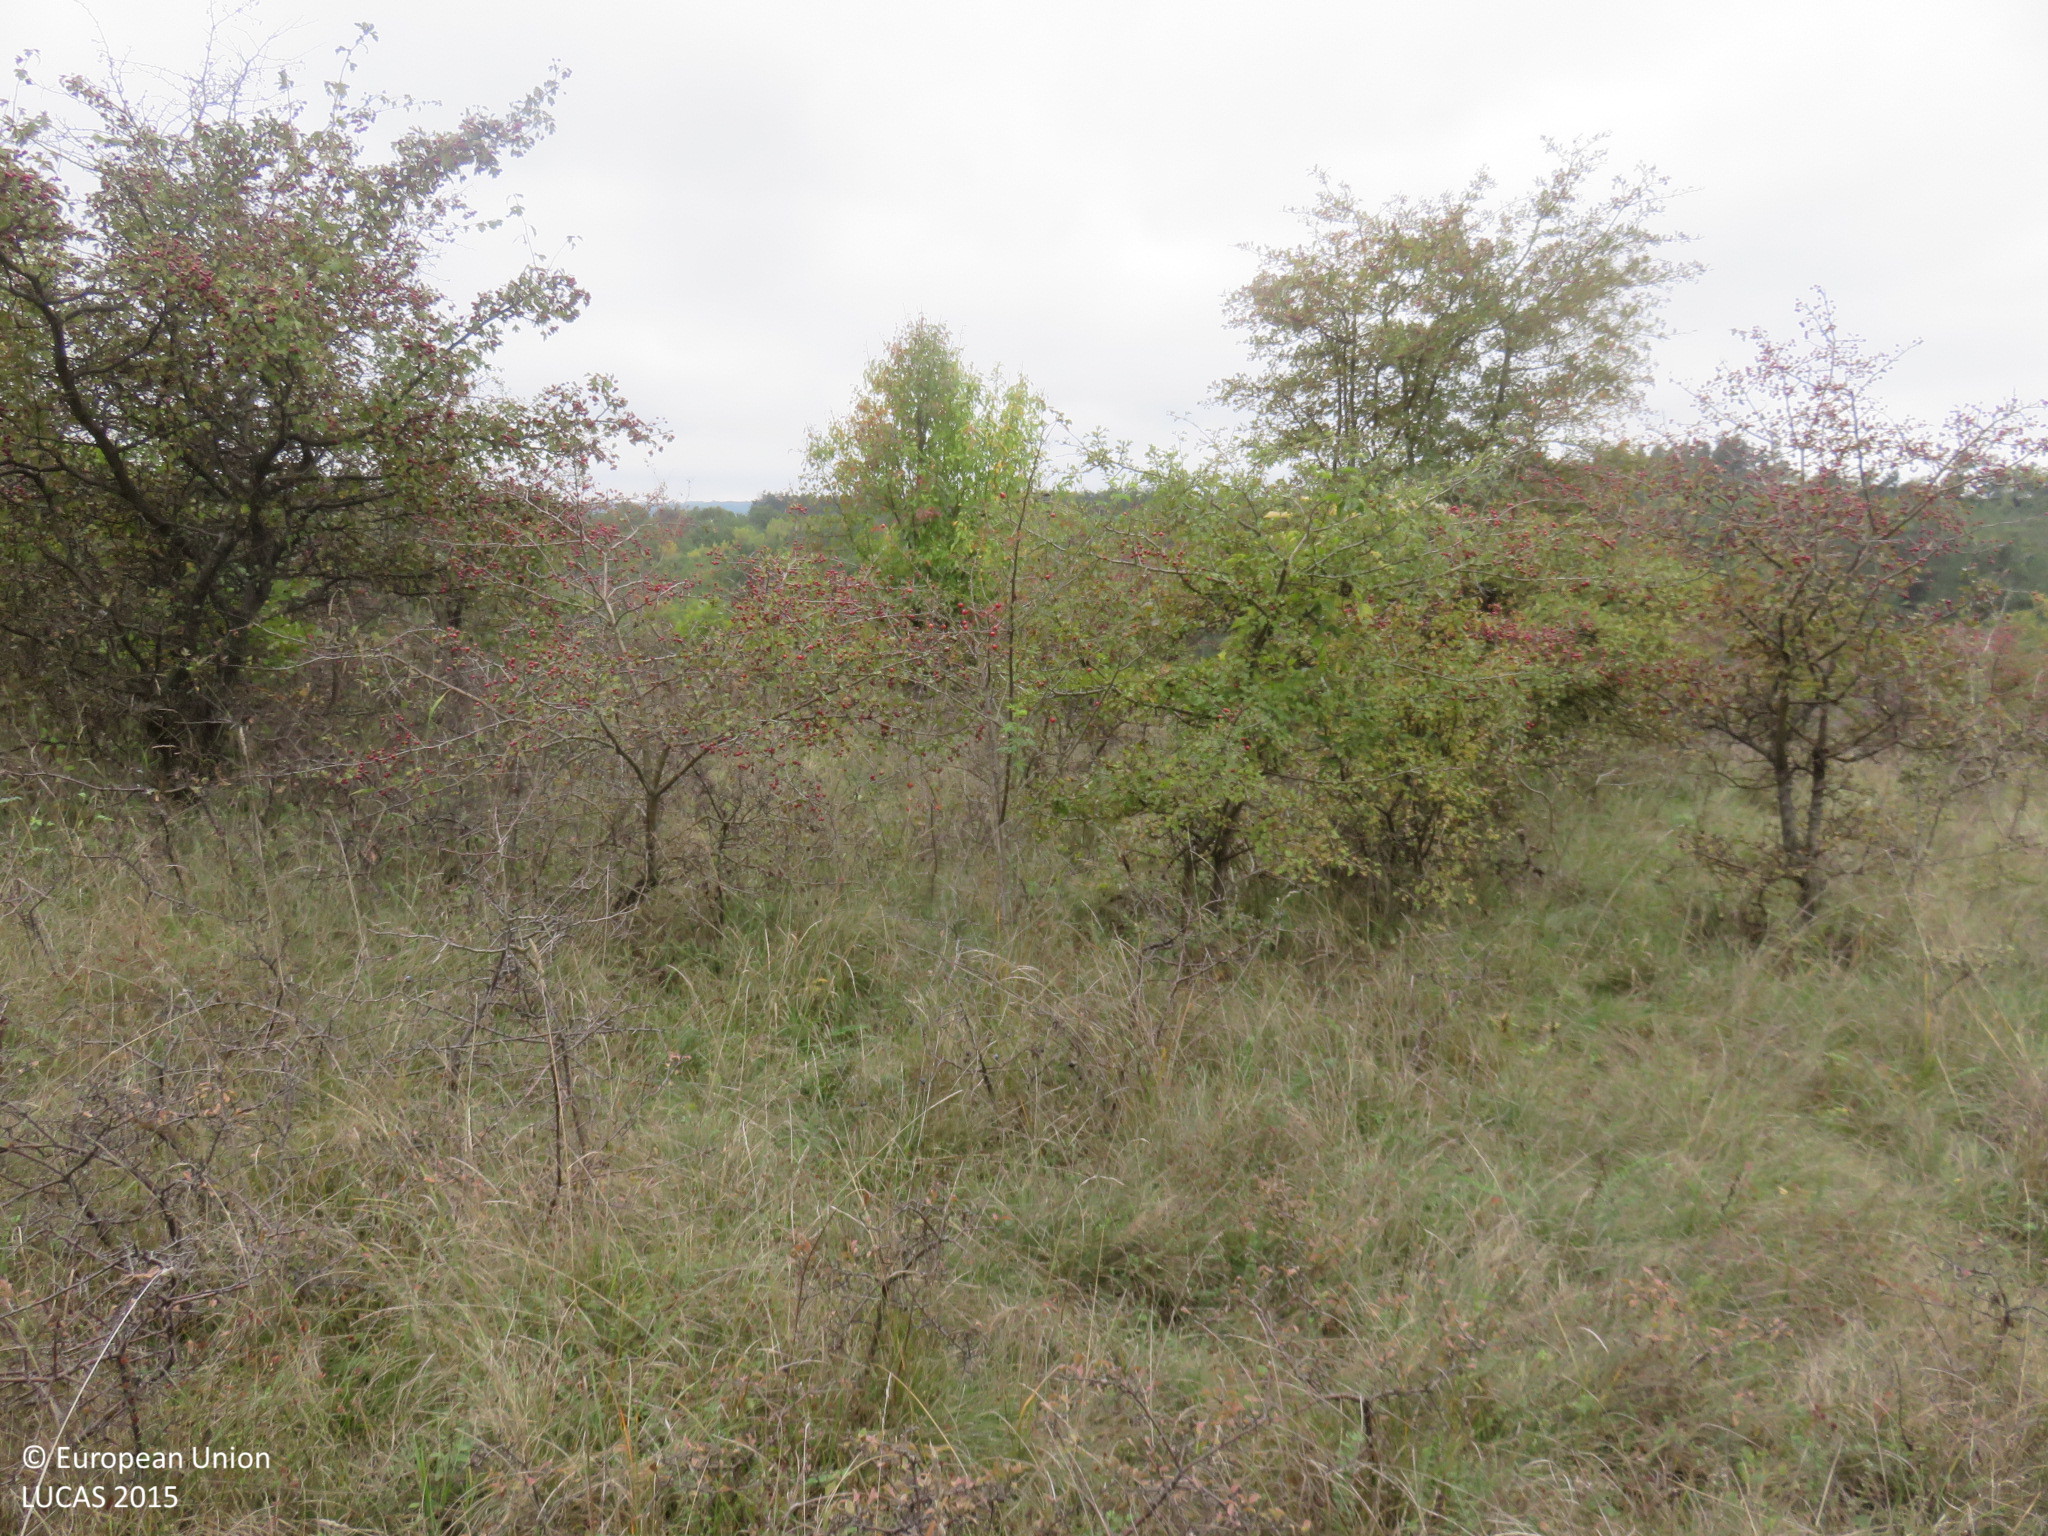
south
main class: Shrubland
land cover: Shrubland with sparse tree cover
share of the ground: > 75 %
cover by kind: shrubs 95 %, broadleaved forest trees 5 %
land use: Semi-natural and natural areas not in use
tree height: < 5 m
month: October
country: BG
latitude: 43.0140
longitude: 25.2483
